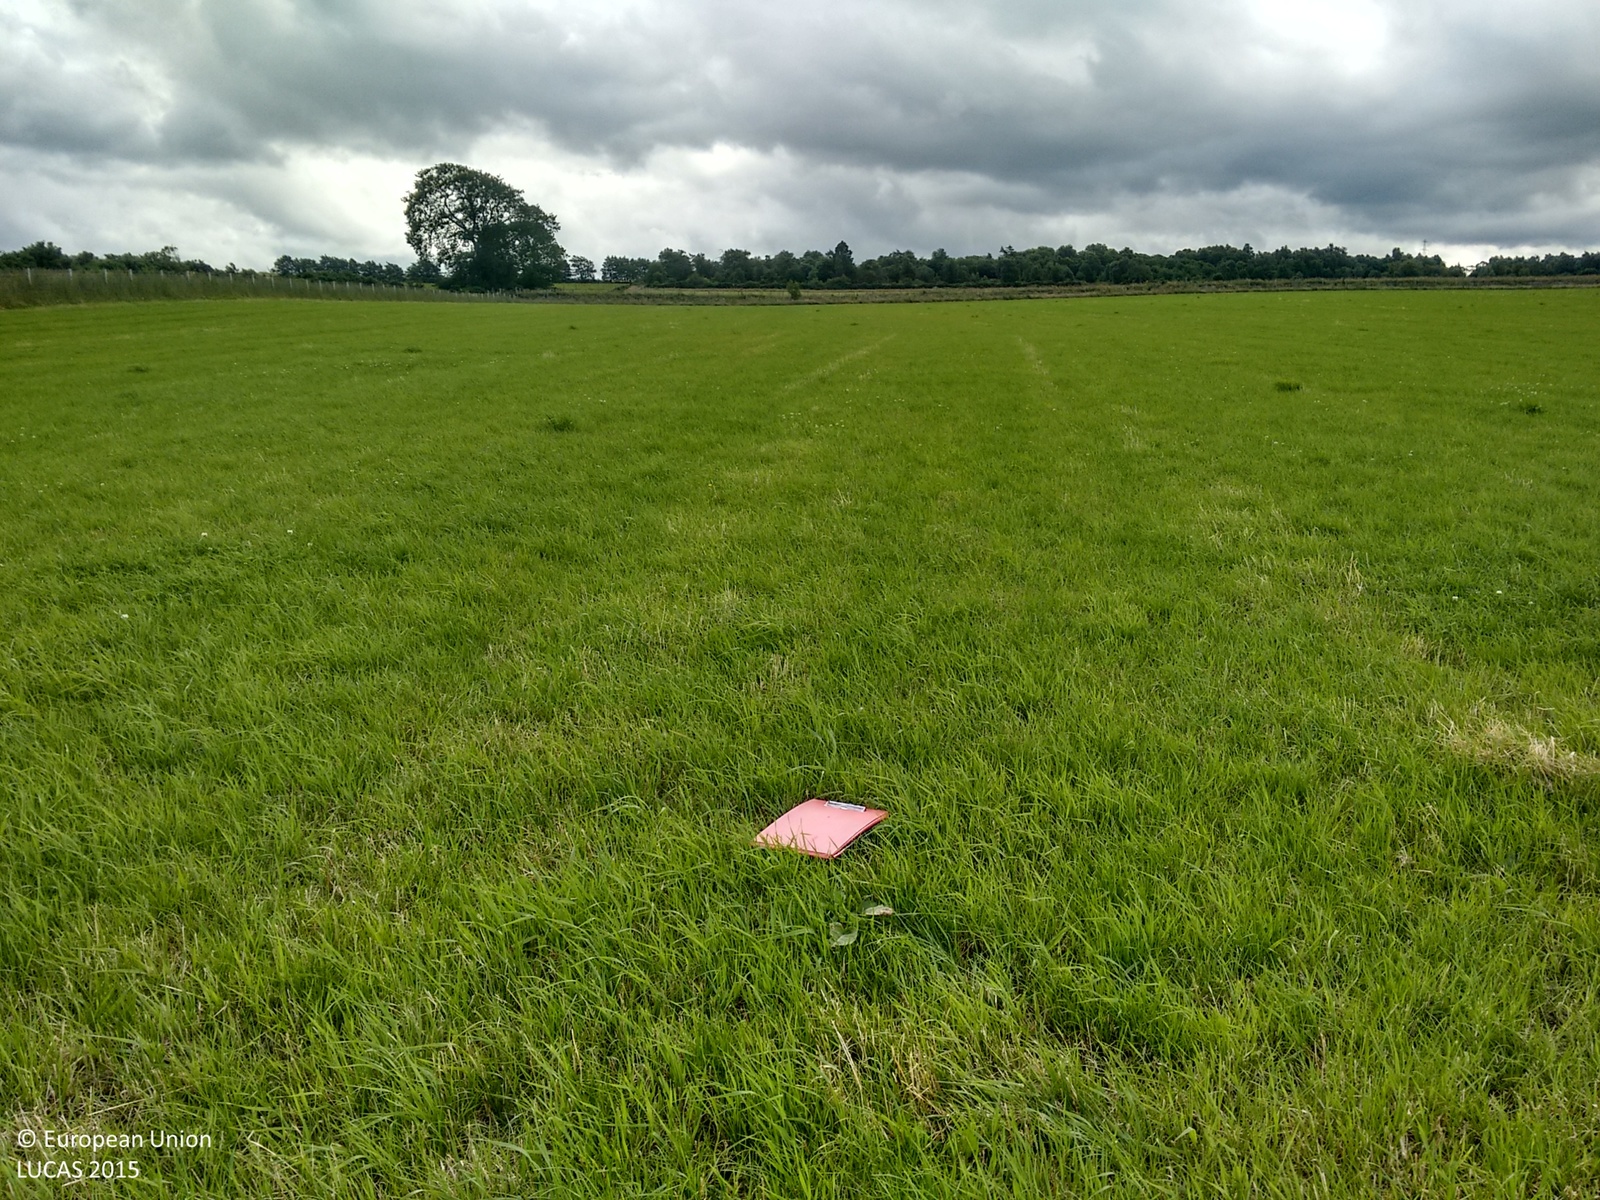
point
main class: Grassland
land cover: Grassland without tree/shrub cover
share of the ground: > 75 %
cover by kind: herbaceous plants 100 %
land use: Agriculture (excluding fallow land and kitchen gardens)
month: August
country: GB
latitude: 57.4386
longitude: -4.2291
